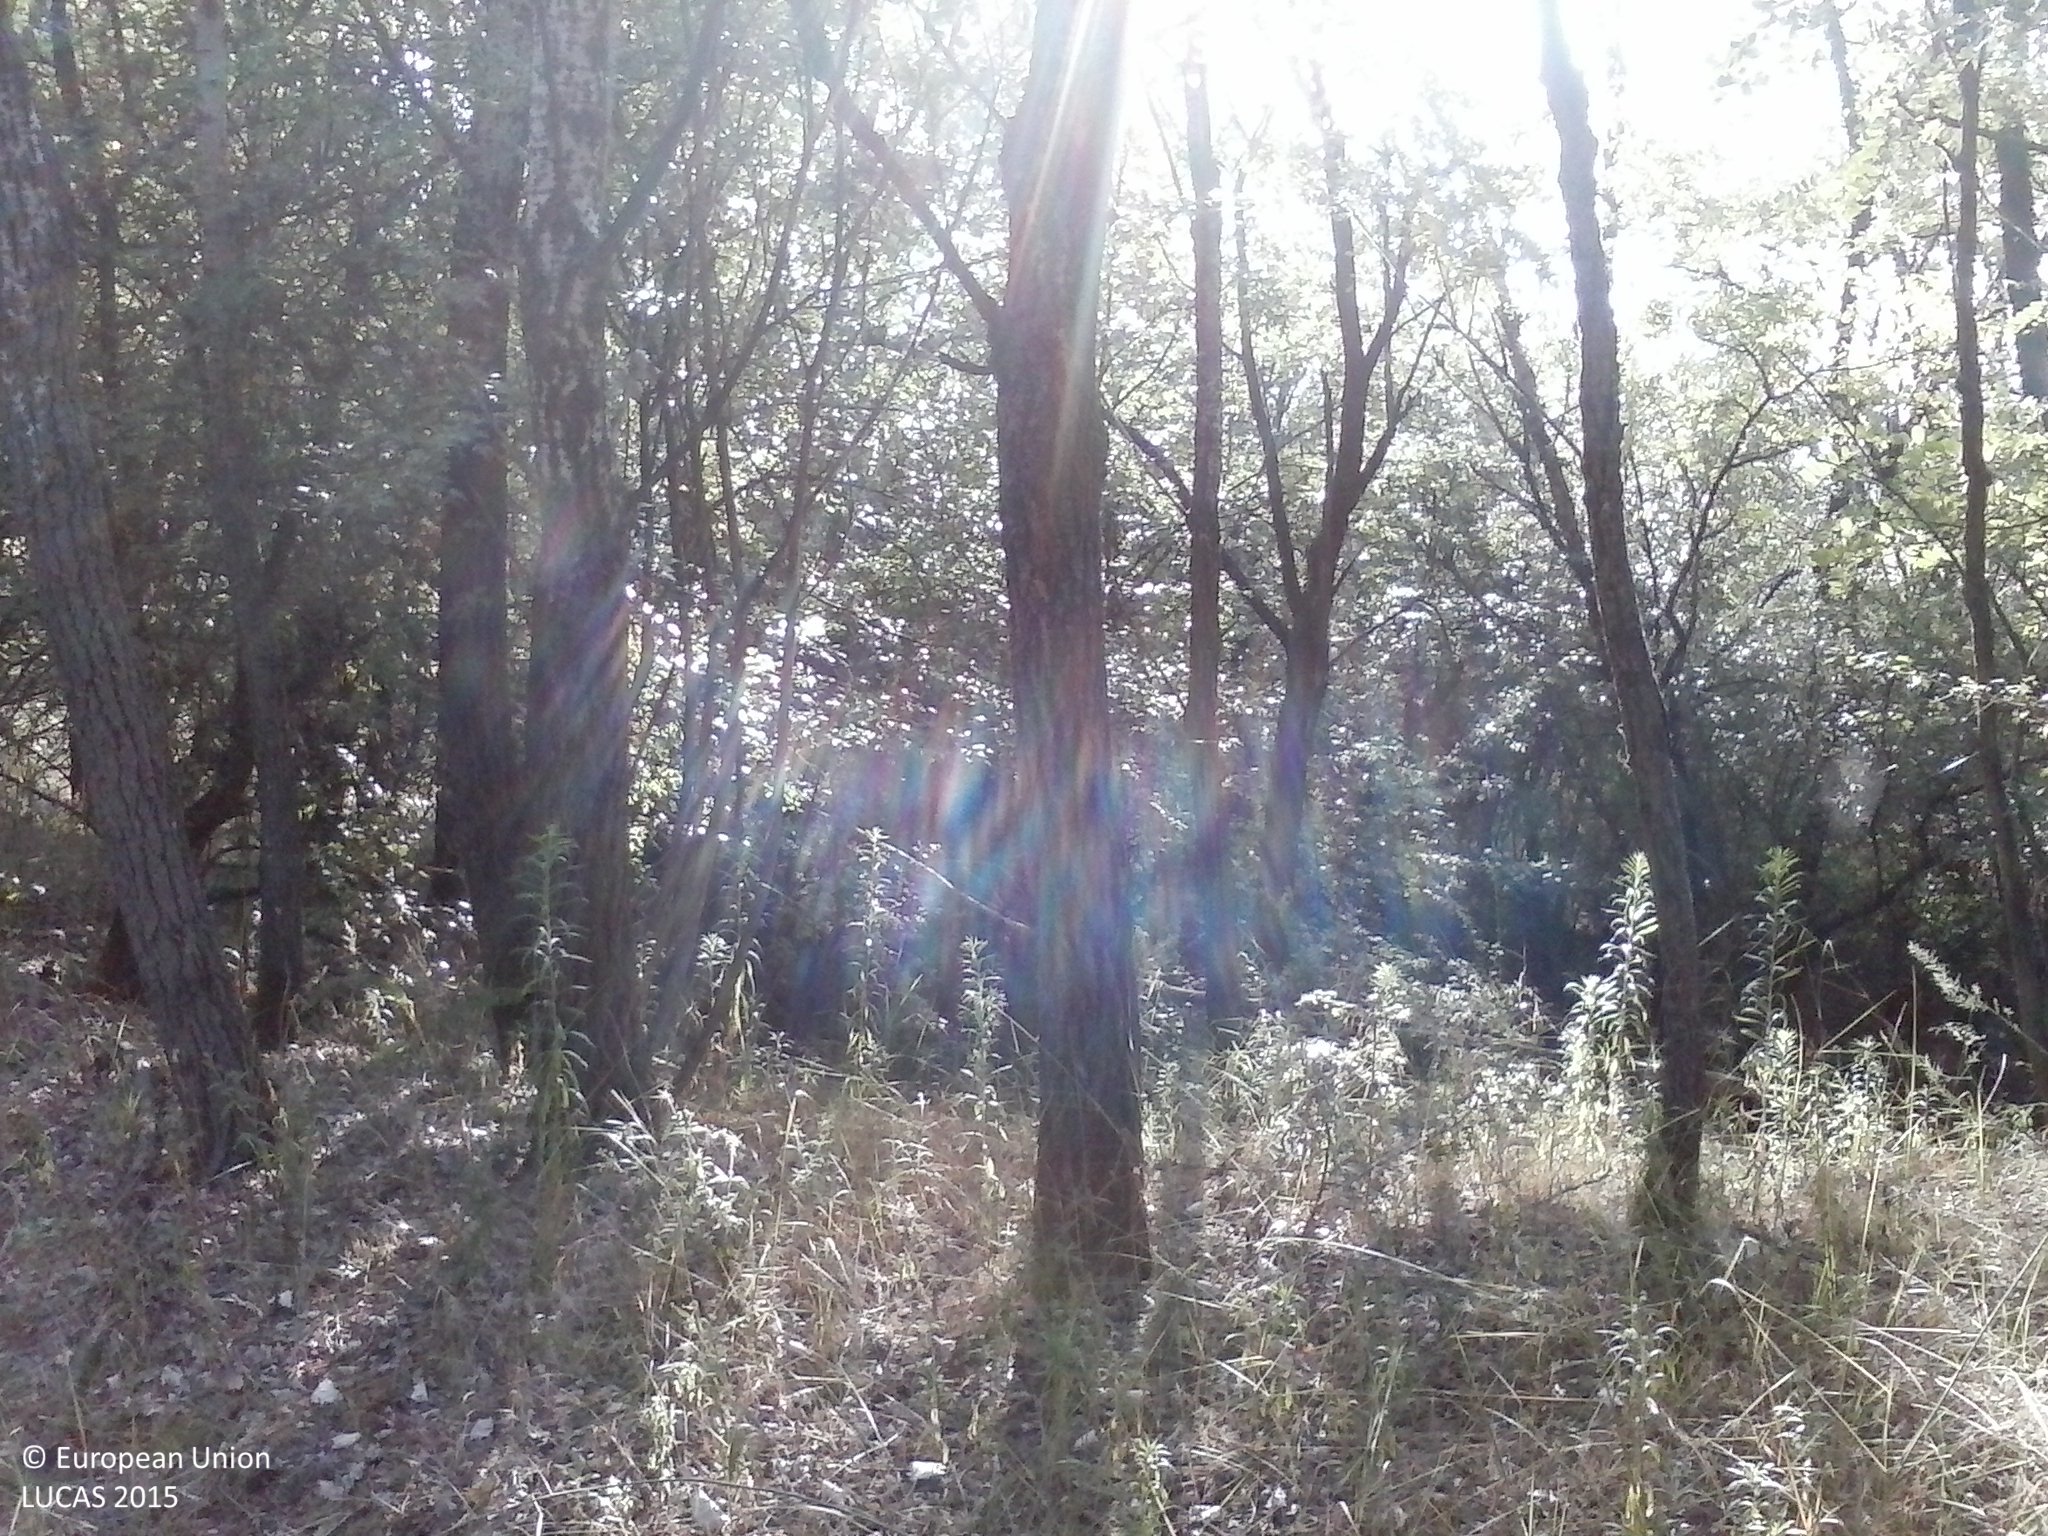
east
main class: Woodland
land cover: Broadleaved woodland
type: mesophytic deciduous forest
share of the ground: > 75 %
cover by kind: broadleaved forest trees 80 %, shrubs 10 %, herbaceous plants 10 %
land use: Forestry
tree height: > 5 m
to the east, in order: Broadleaved woodland; Grassland without tree/shrub cover; Broadleaved woodland; Tracks; Broadleaved woodland; Grassland with sparse tree/shrub cover
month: July
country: HU
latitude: 46.4410
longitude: 19.6373
